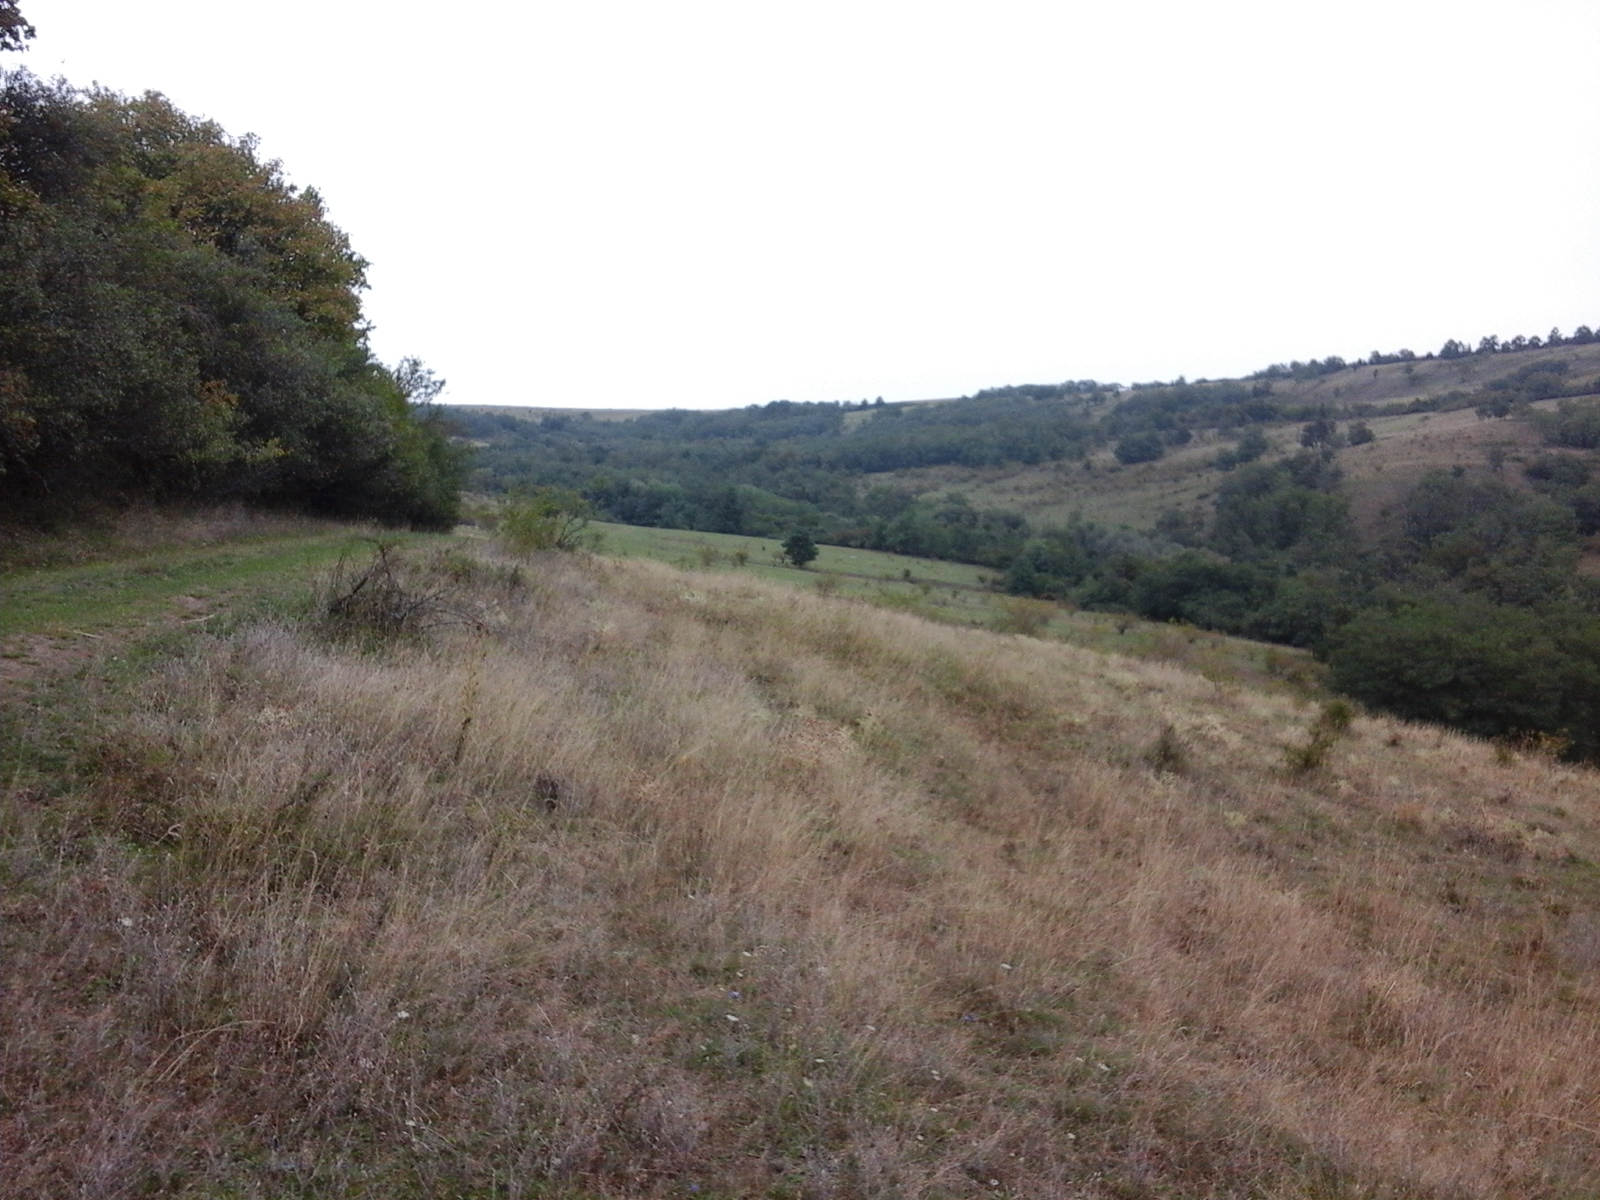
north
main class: Grassland
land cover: Grassland with sparse tree/shrub cover
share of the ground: > 75 %
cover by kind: herbaceous plants 85 %, shrubs 10 %, broadleaved forest trees 5 %
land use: Agriculture (excluding fallow land and kitchen gardens)
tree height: < 5 m
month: September
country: RO
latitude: 47.3259
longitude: 22.5071
